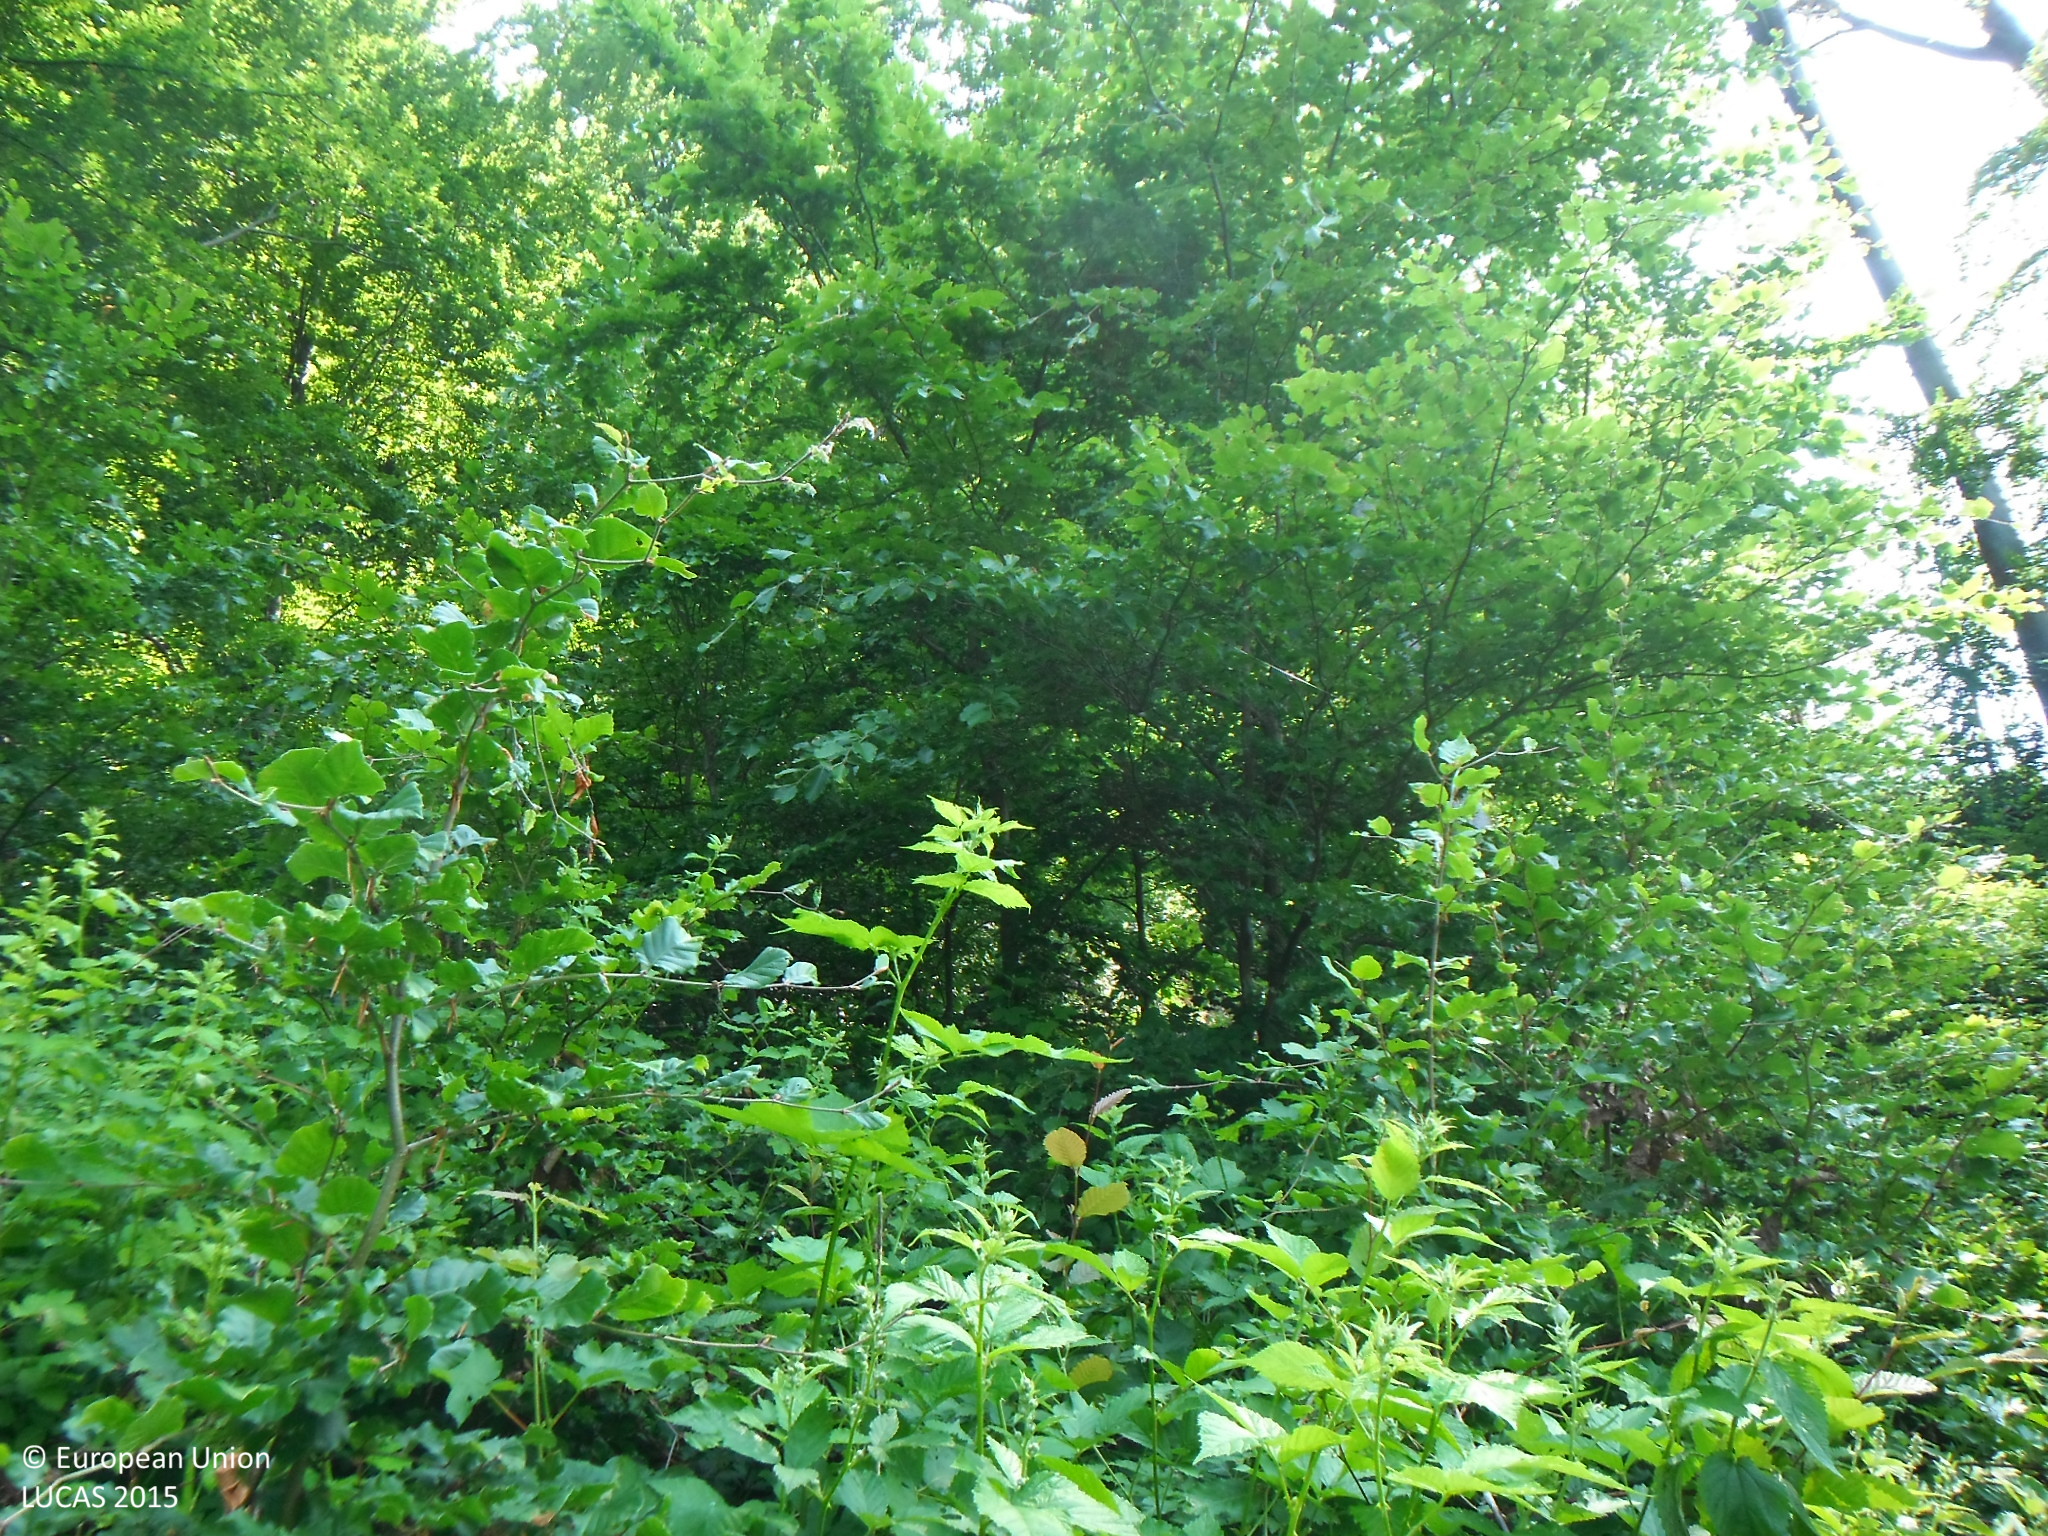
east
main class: Woodland
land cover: Broadleaved woodland
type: beech forest
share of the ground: 50 - 75 %
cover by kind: broadleaved forest trees 60 %, herbaceous plants 40 %
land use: Forestry
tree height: < 5 m
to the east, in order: Broadleaved woodland; Tracks; Broadleaved woodland; Tracks; Broadleaved woodland; Tracks; Broadleaved woodland
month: June
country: SK
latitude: 48.8723
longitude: 21.1553
